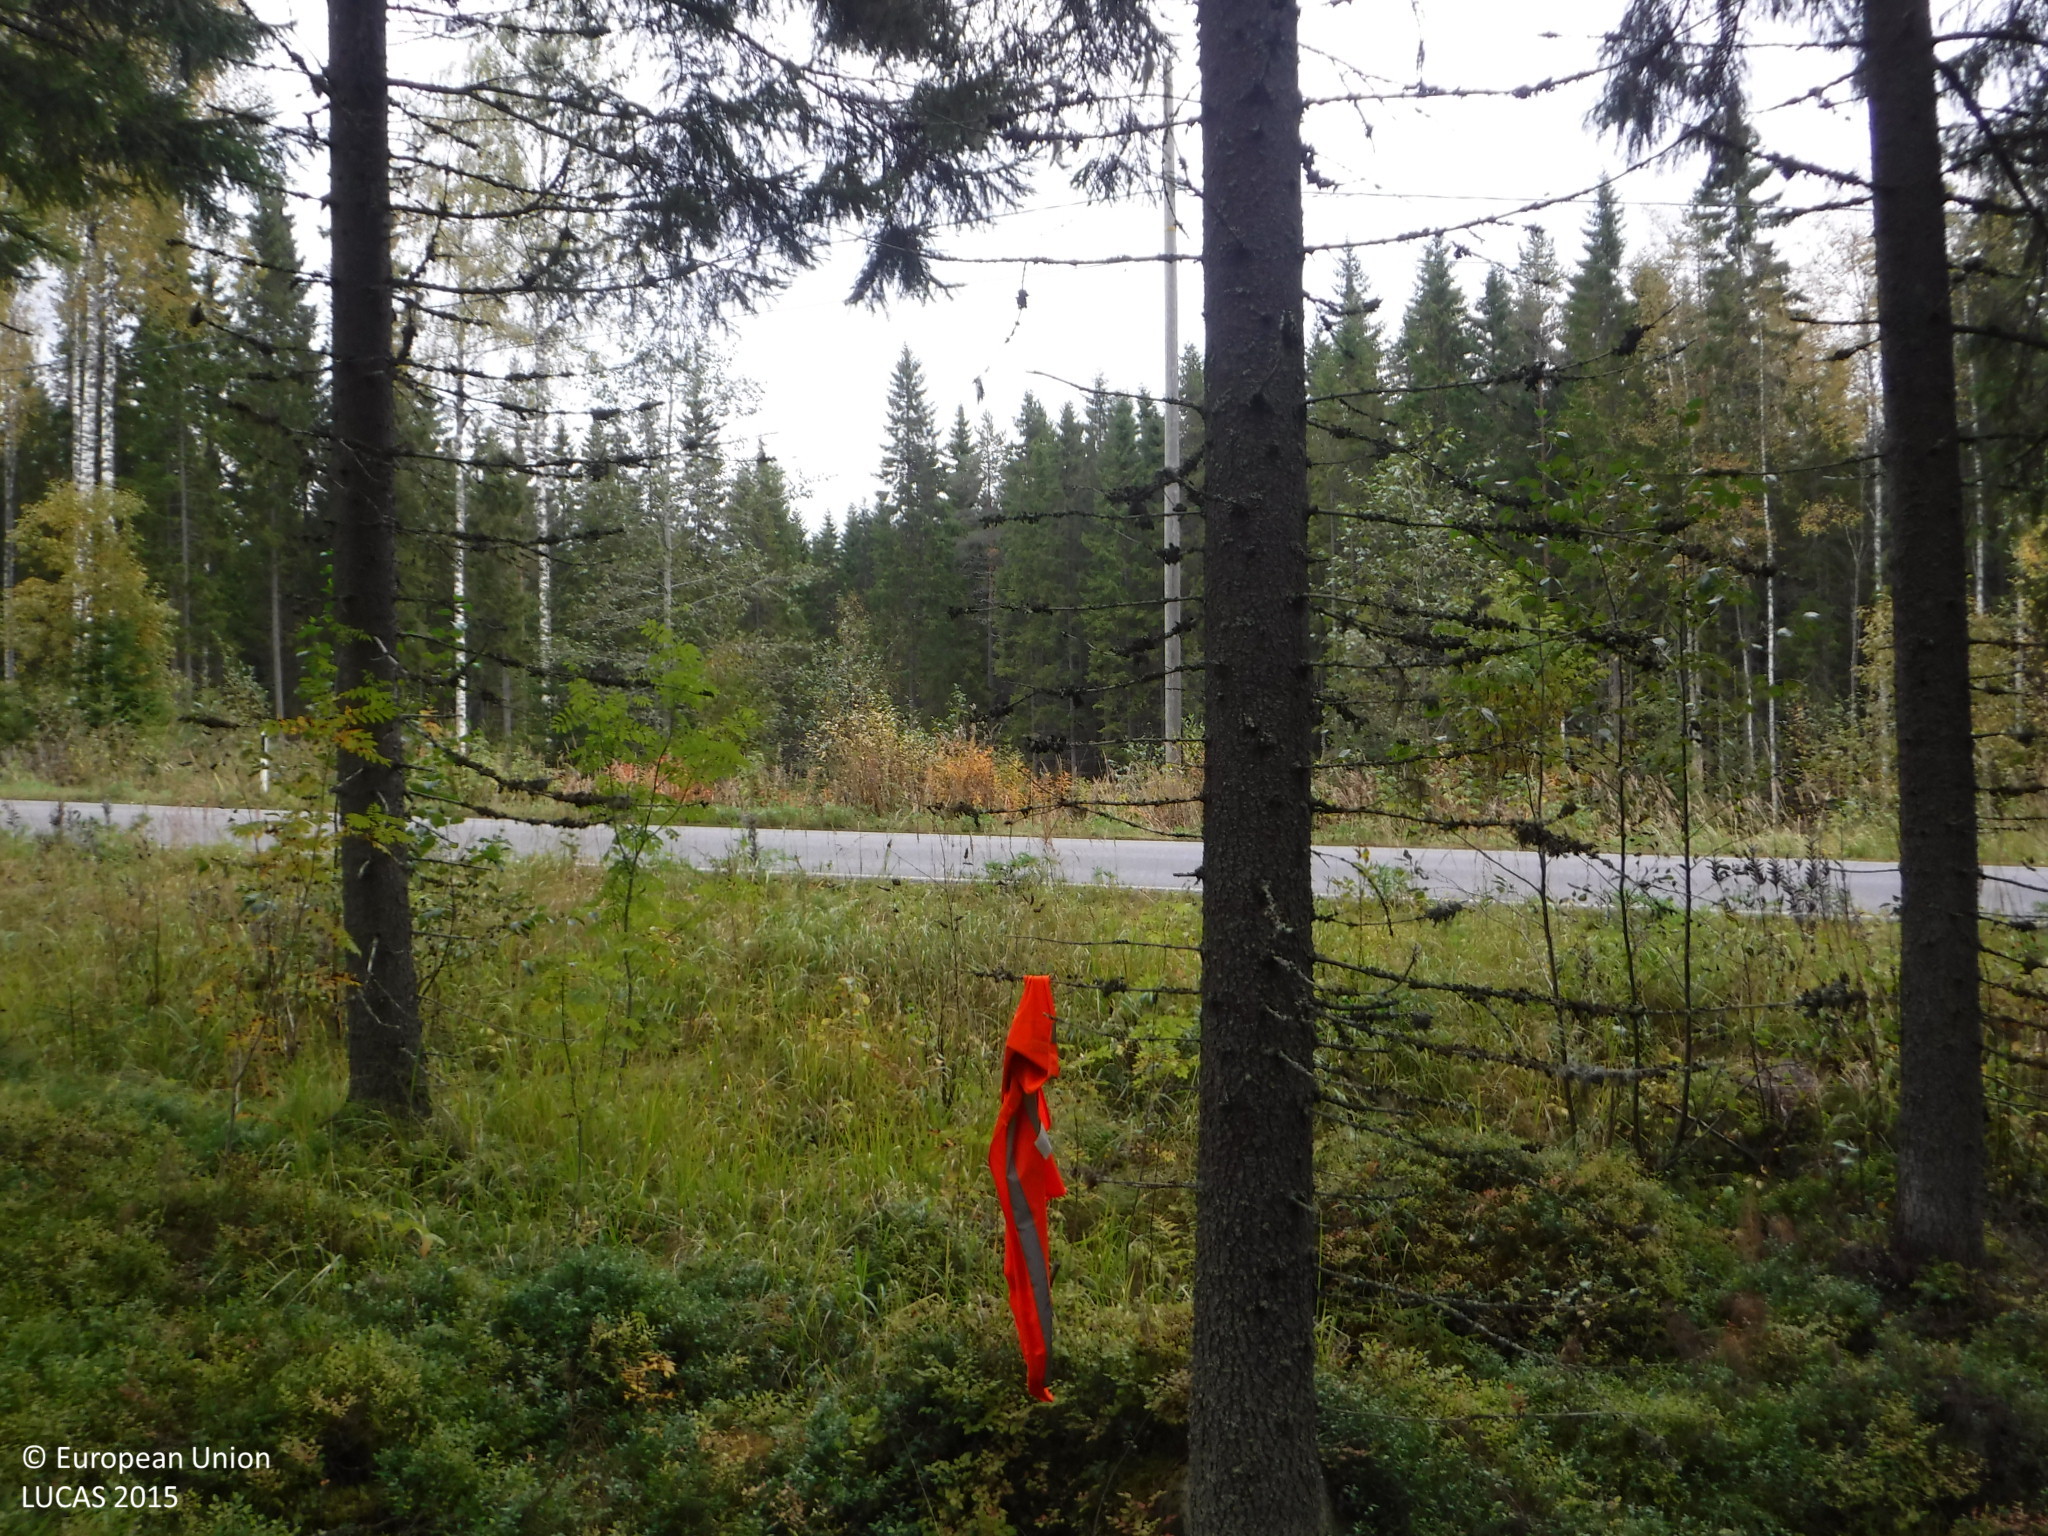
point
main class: Woodland
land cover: Spruce dominated coniferous woodland
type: boreal forest
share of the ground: 50 - 75 %
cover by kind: coniferous forest trees 70 %, shrubs 15 %, lichens and mosses 15 %
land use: Forestry
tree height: > 5 m
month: September
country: FI
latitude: 62.1237
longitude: 23.3578
